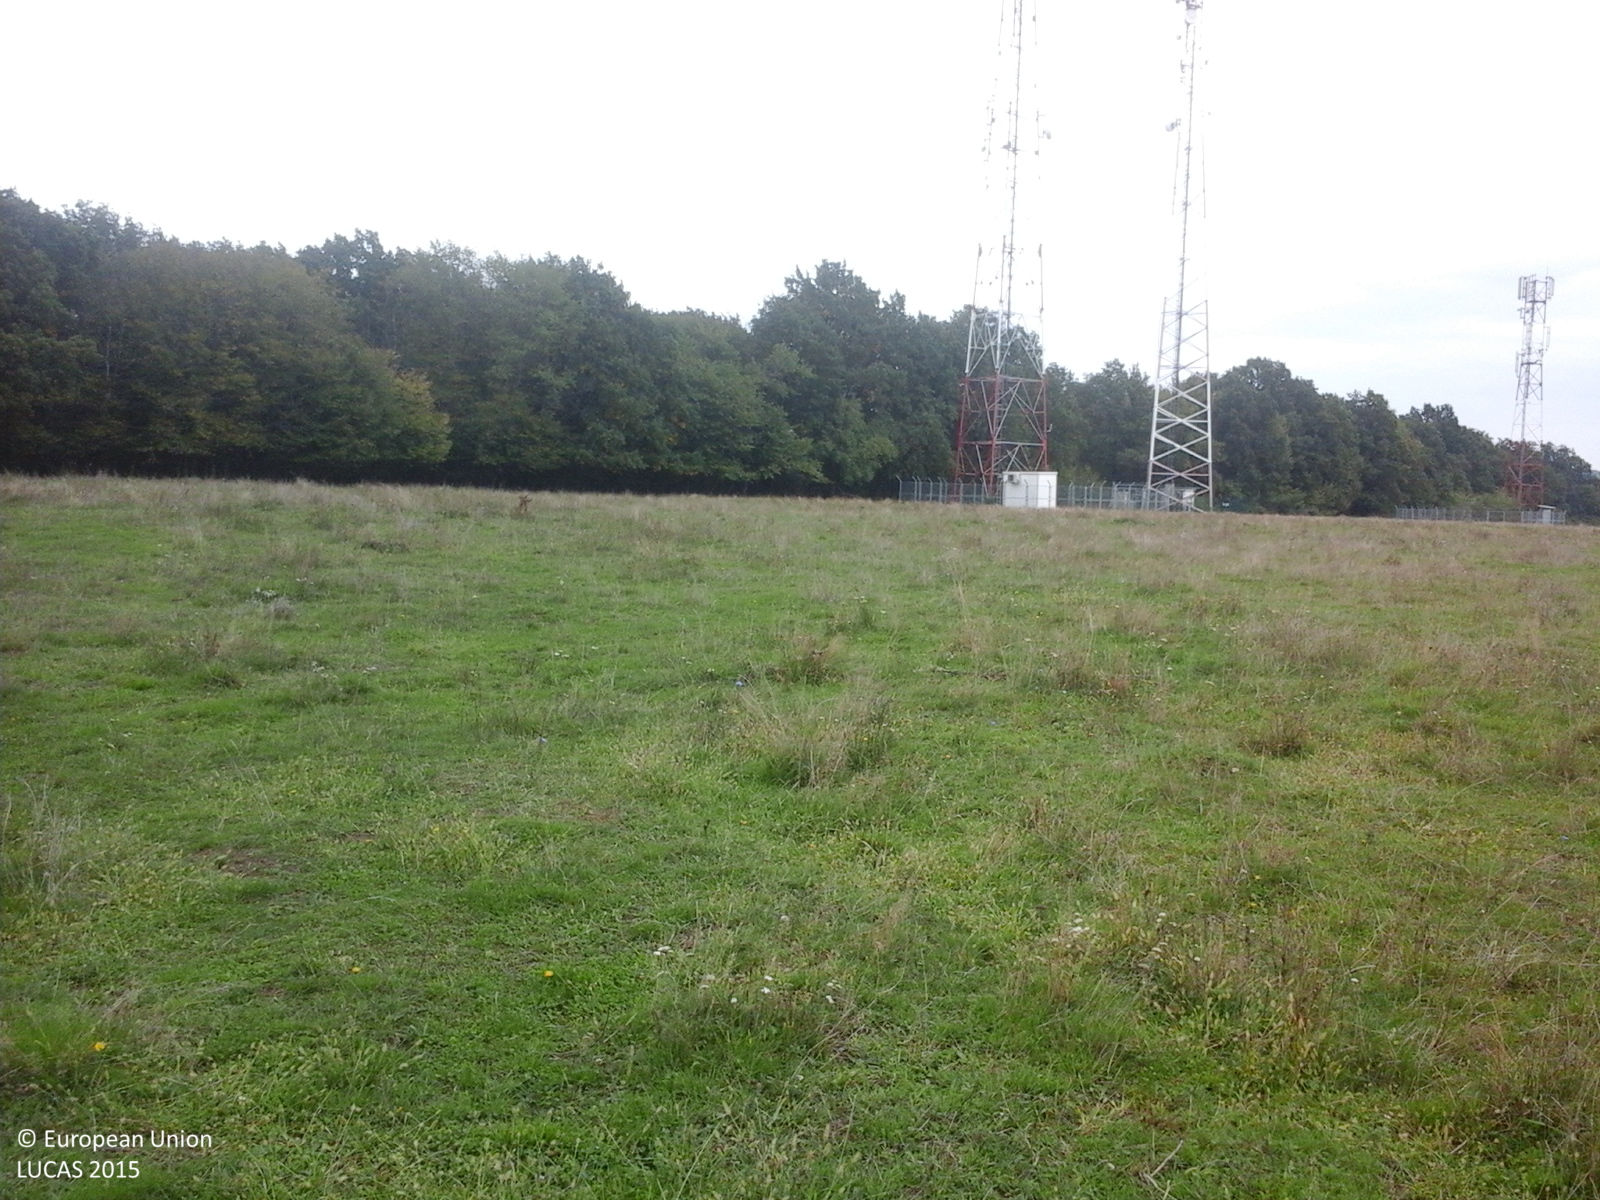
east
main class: Grassland
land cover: Grassland without tree/shrub cover
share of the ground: > 75 %
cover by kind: herbaceous plants 100 %
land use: Agriculture (excluding fallow land and kitchen gardens)
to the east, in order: Grassland without tree/shrub cover; Broadleaved woodland
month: October
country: RO
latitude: 46.5280
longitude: 24.7589
